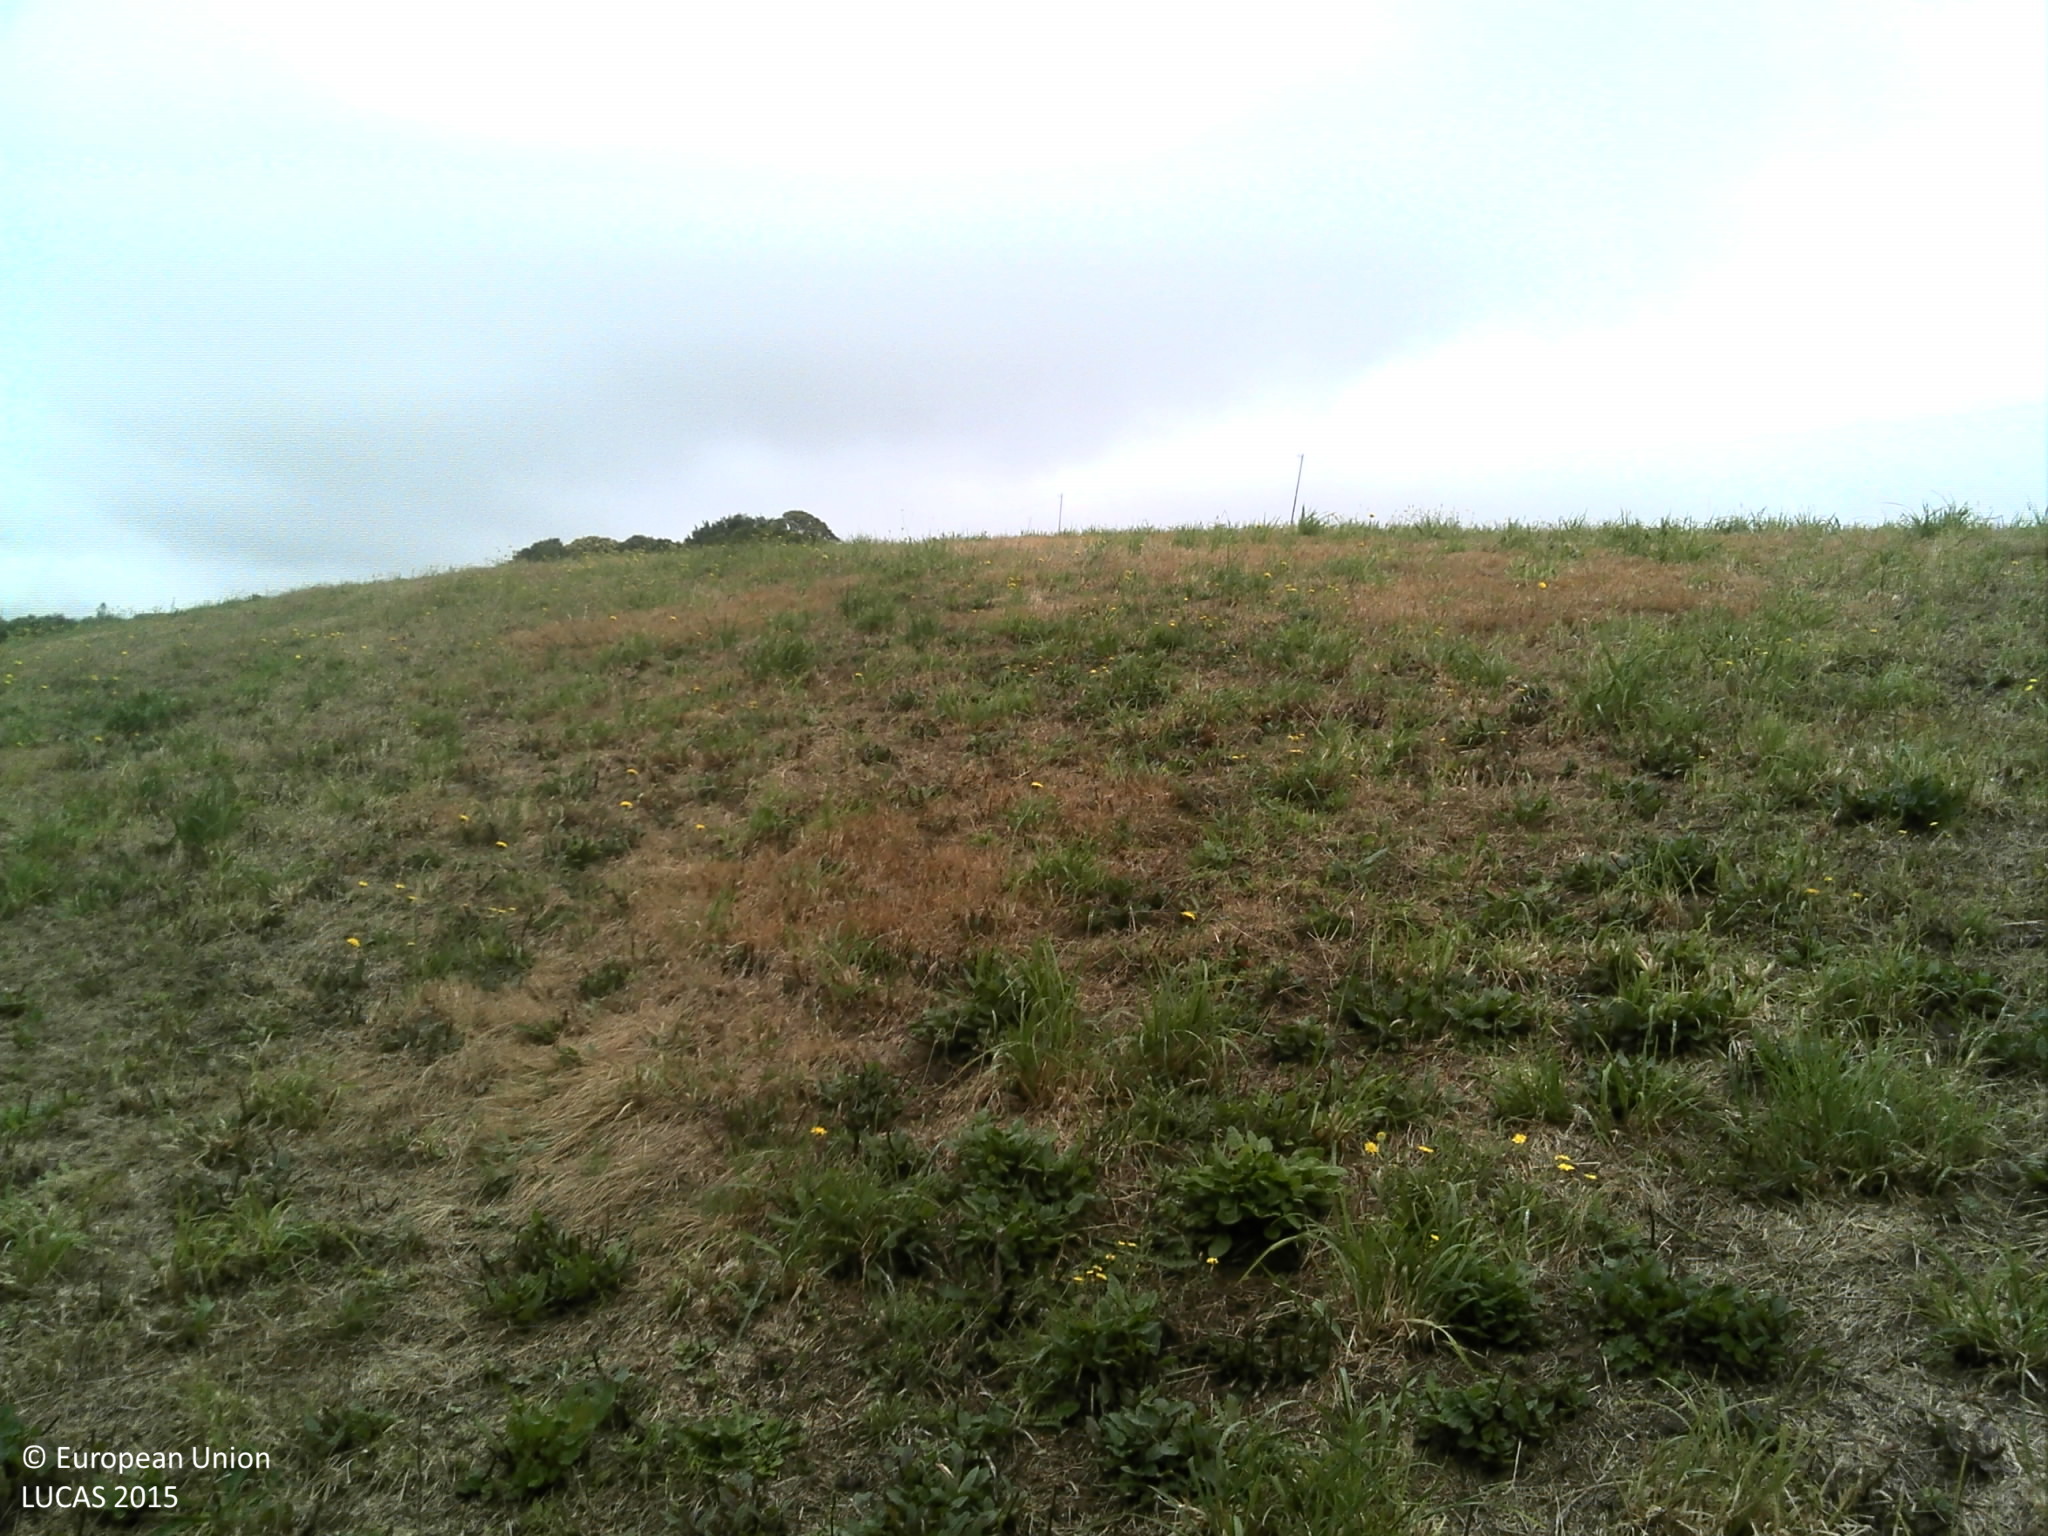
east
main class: Grassland
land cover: Grassland without tree/shrub cover
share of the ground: > 75 %
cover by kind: herbaceous plants 100 %
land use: Agriculture (excluding fallow land and kitchen gardens)
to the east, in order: Grassland without tree/shrub cover; Fences; Grassland without tree/shrub cover; Fences; Tracks; Lines of trees; Temporary grasslands
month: July
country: FR
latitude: 48.0488
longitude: -4.1897
